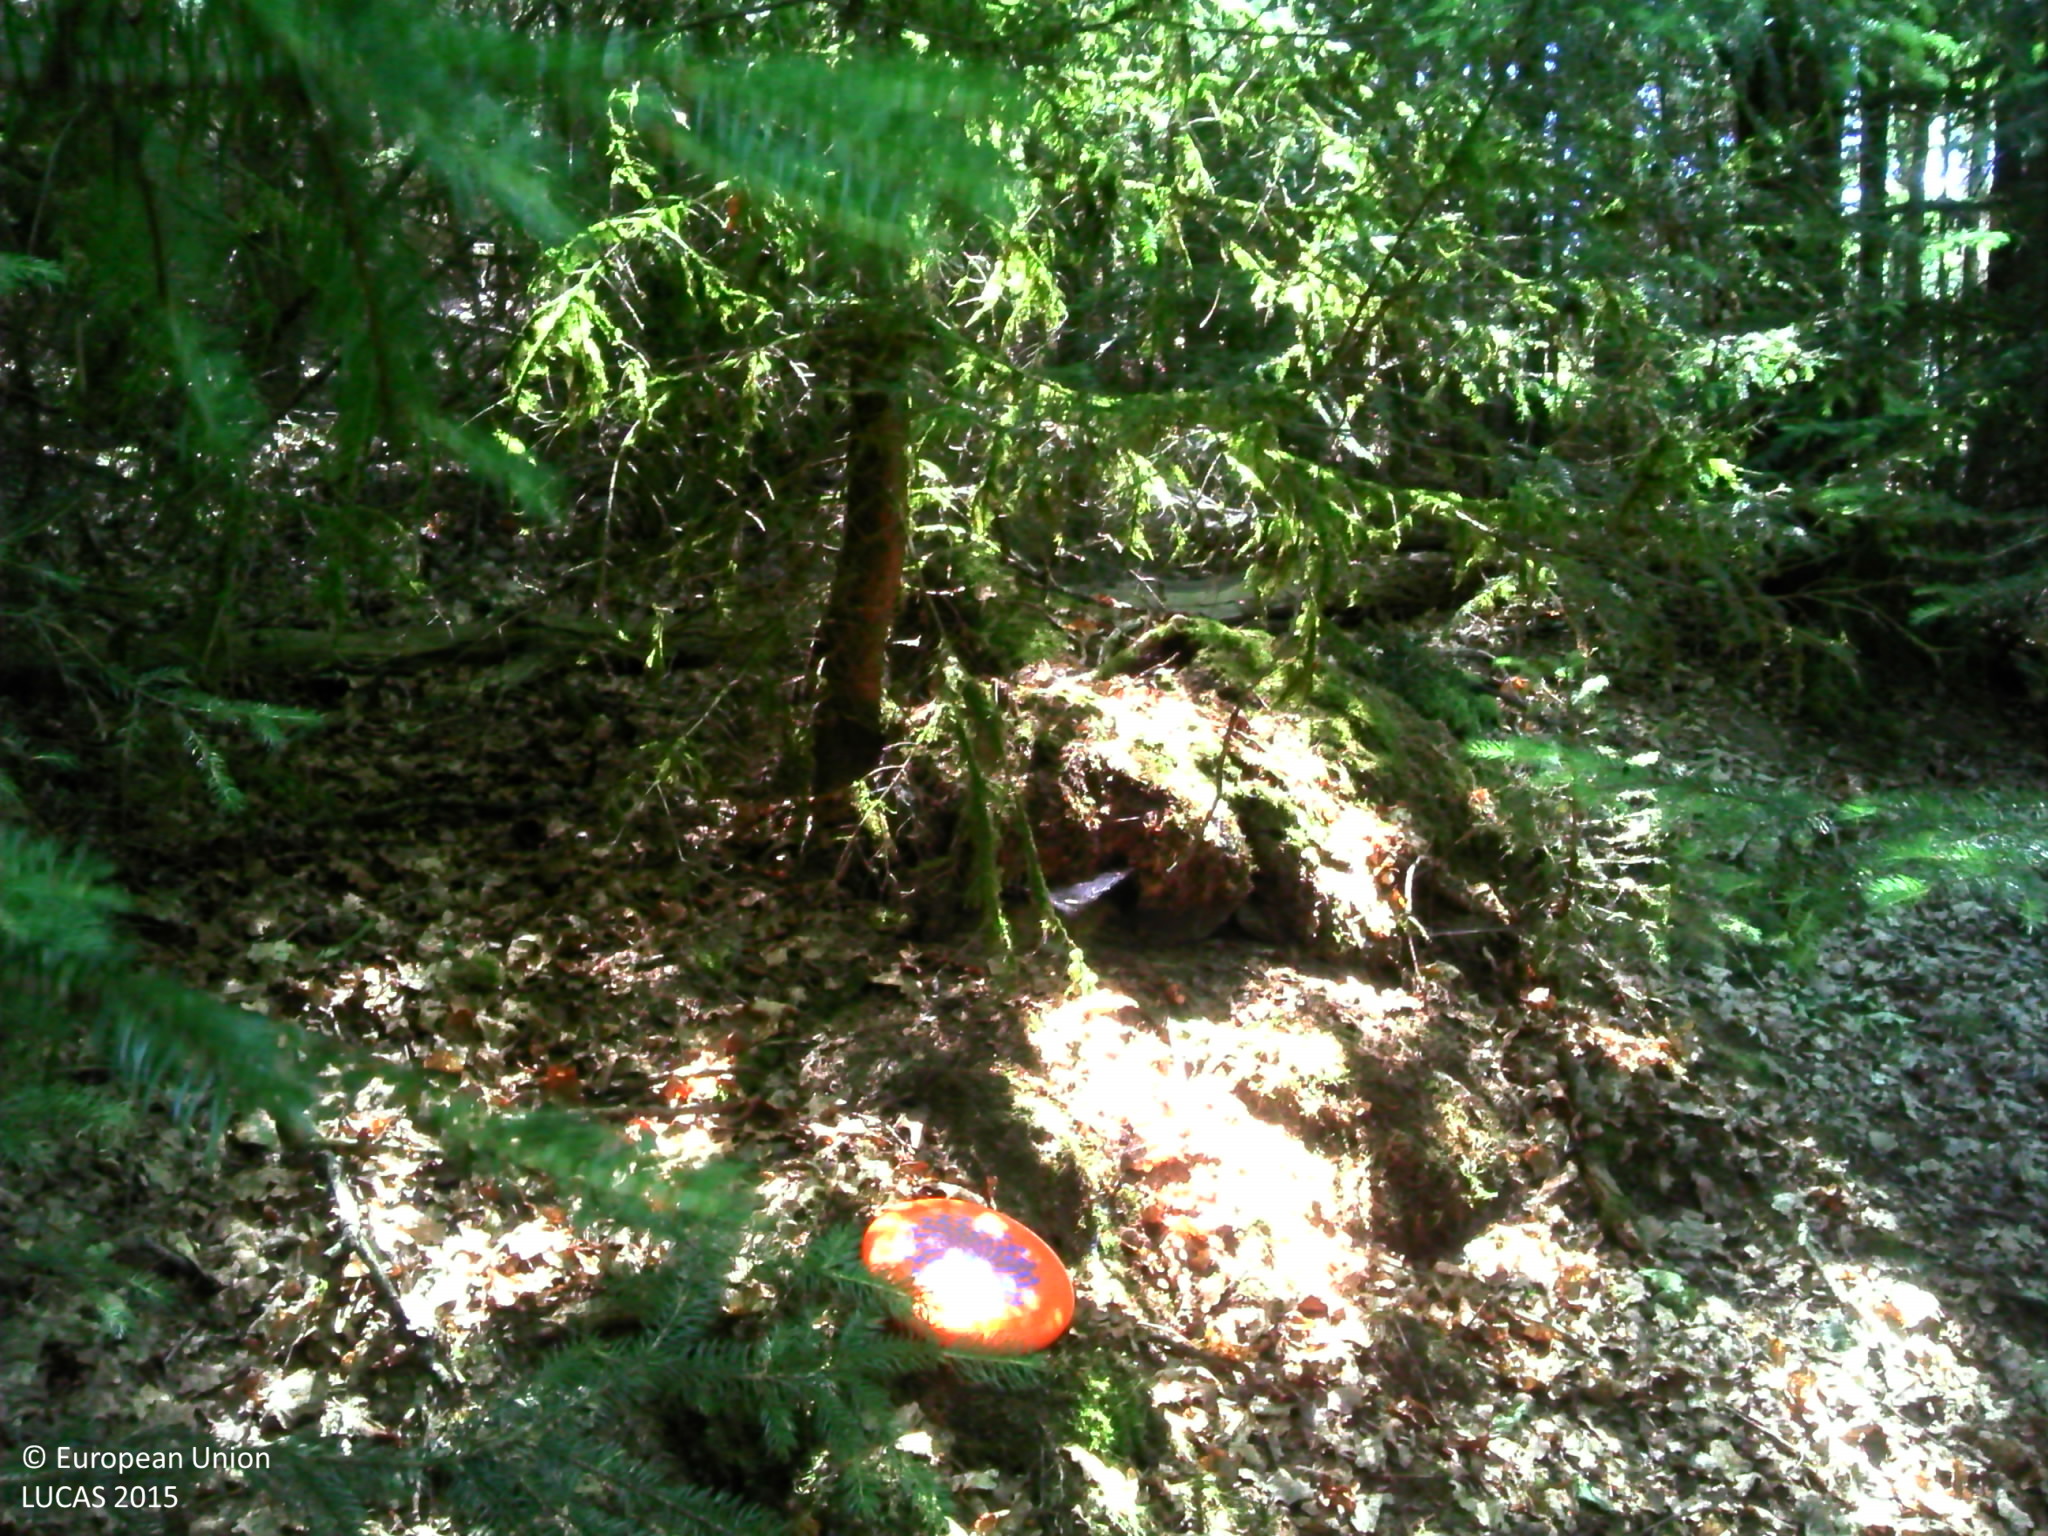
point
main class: Woodland
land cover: Spruce dominated mixed woodland
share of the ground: > 75 %
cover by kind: broadleaved forest trees 60 %, coniferous forest trees 40 %
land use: Forestry
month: July
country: BE
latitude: 50.0801
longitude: 5.5685
